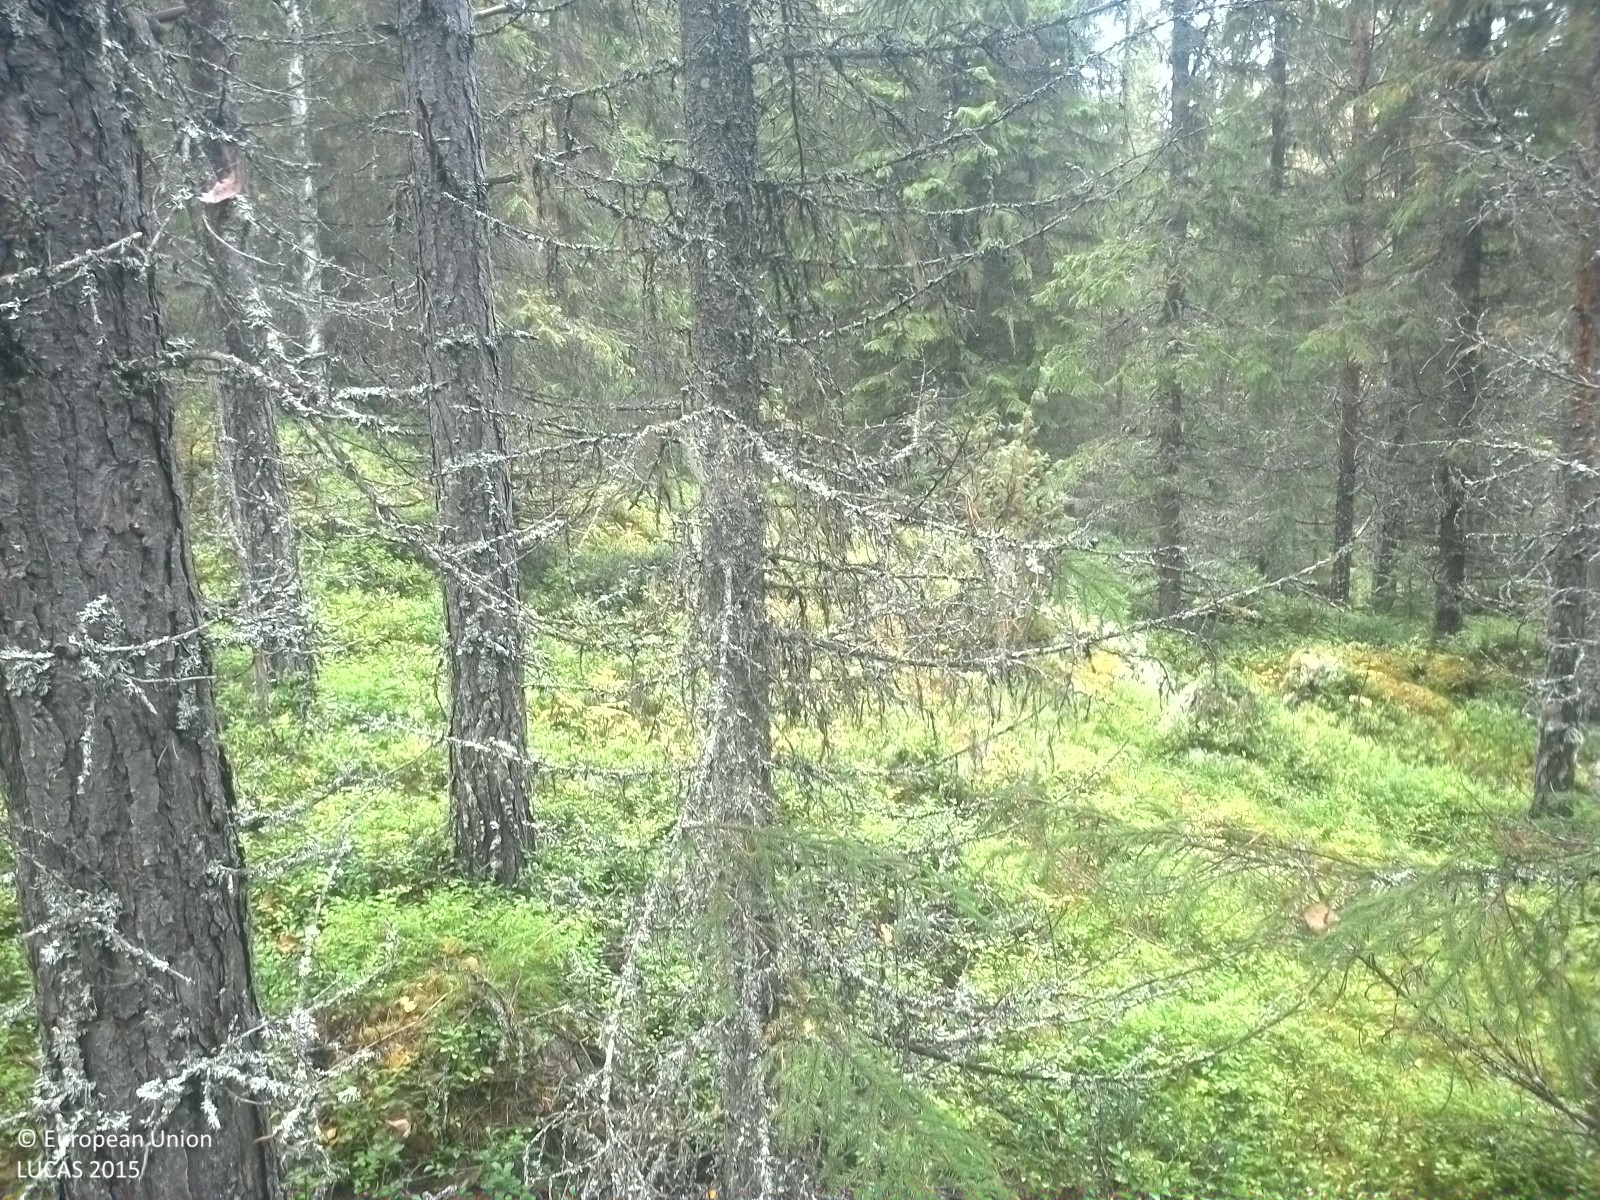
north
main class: Woodland
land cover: Spruce dominated mixed woodland
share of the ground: 50 - 75 %
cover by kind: broadleaved forest trees 40 %, shrubs 40 %, coniferous forest trees 15 %, lichens and mosses 5 %
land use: Forestry
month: September
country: SE
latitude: 62.2722
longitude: 15.6255
